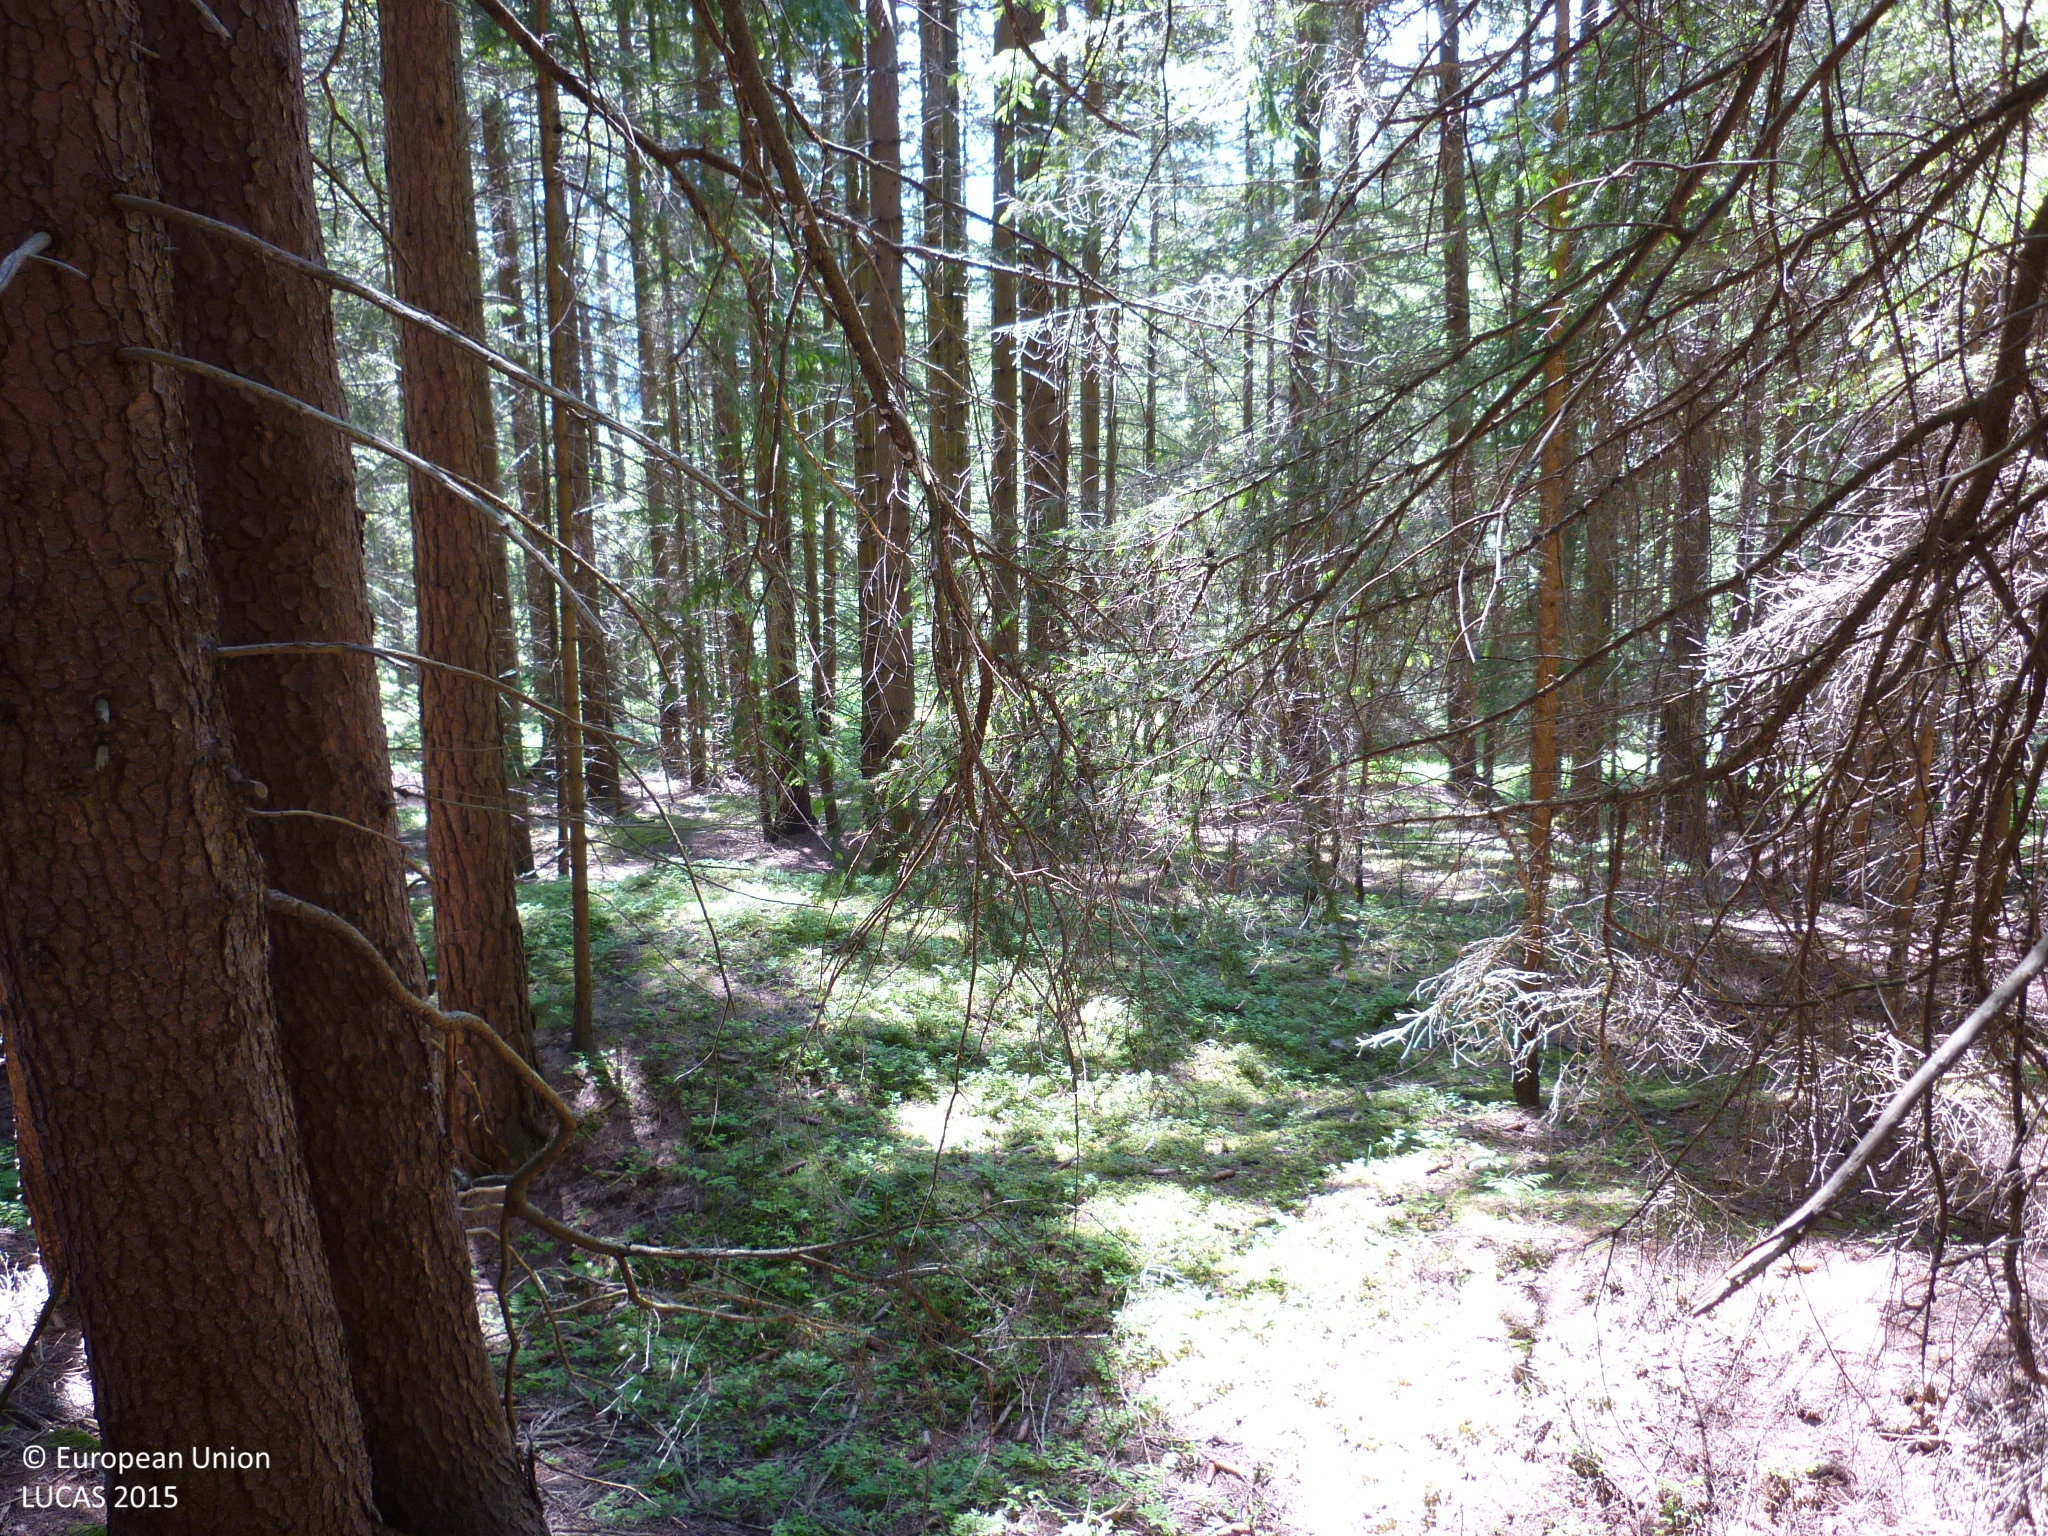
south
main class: Woodland
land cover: Spruce dominated coniferous woodland
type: alpine coniferous forest
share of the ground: > 75 %
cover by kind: coniferous forest trees 100 %
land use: Forestry
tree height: > 5 m
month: May
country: AT
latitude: 47.3042
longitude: 14.8798
